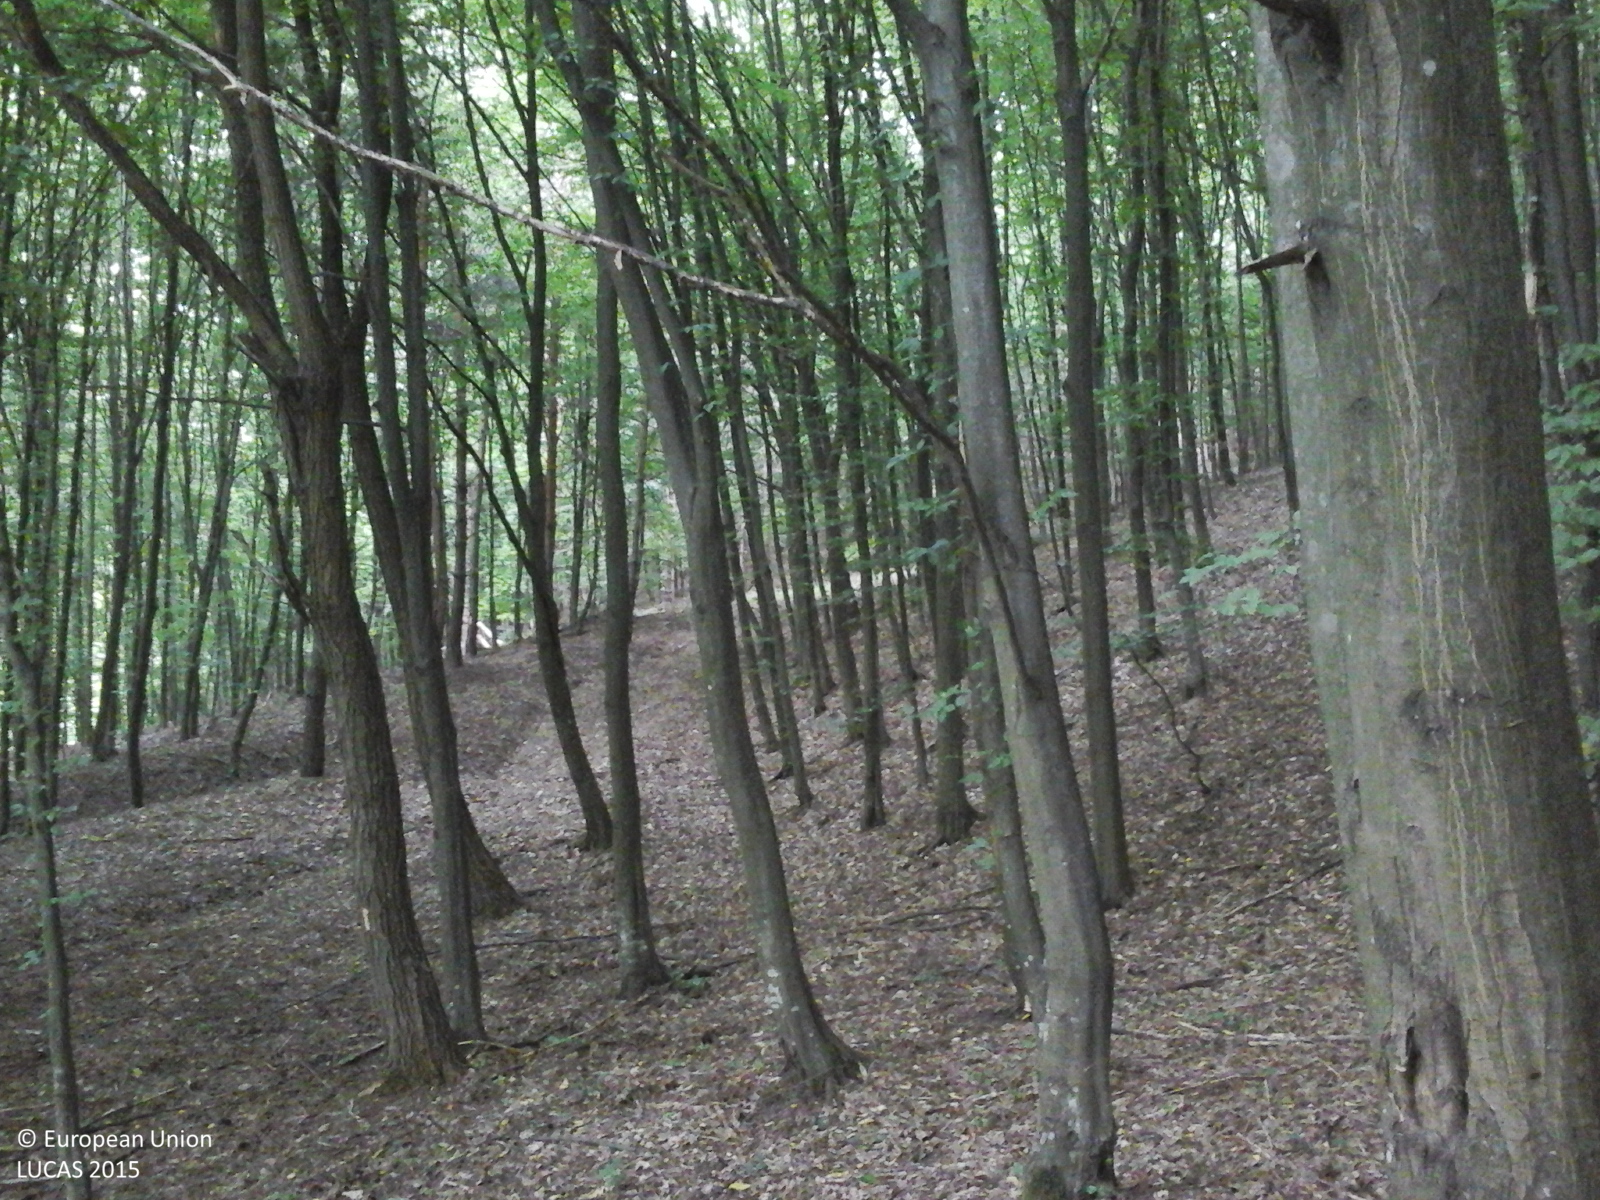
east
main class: Woodland
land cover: Broadleaved woodland
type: beech forest
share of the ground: > 75 %
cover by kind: broadleaved forest trees 100 %
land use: Forestry
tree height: > 5 m
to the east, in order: Broadleaved woodland
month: July
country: RO
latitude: 44.8325
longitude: 24.4551
